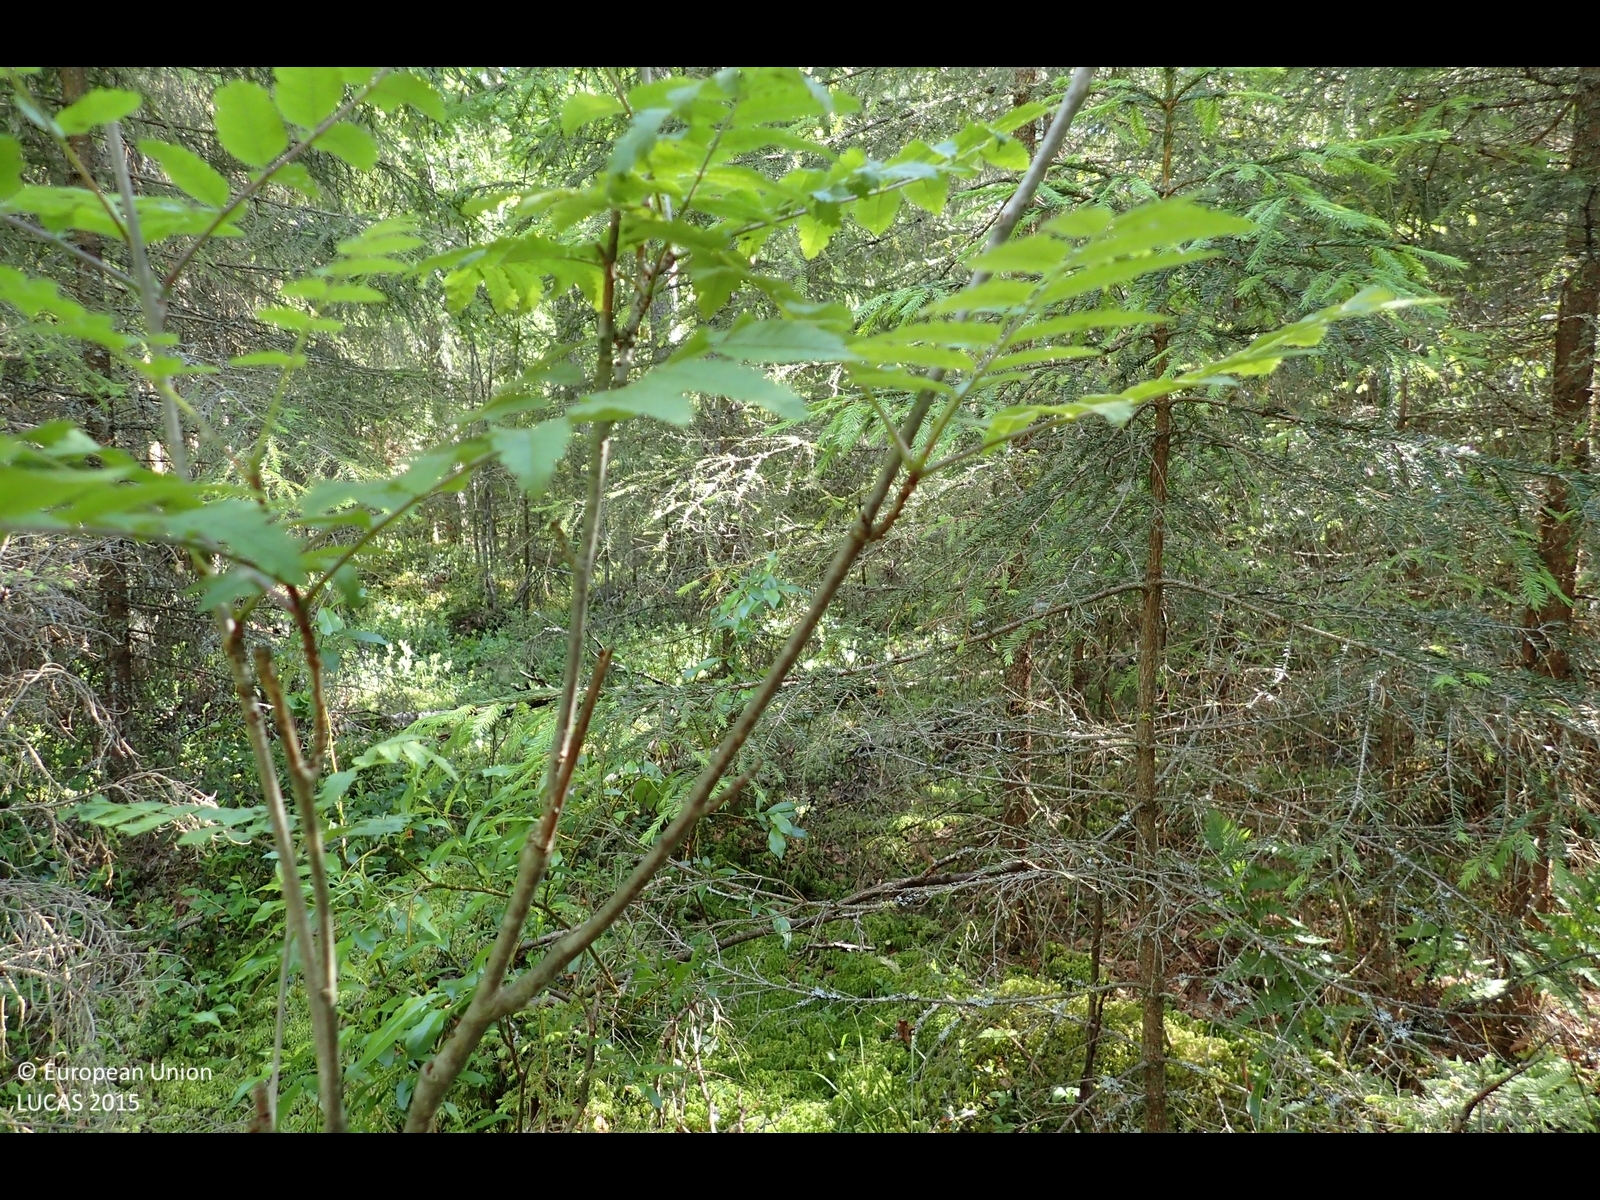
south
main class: Woodland
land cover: Other mixed woodland
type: boreal forest
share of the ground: > 75 %
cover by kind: coniferous forest trees 60 %, broadleaved forest trees 20 %, shrubs 10 %, lichens and mosses 10 %
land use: Forestry
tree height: > 5 m
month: July
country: FI
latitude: 62.6130
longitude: 21.6778
